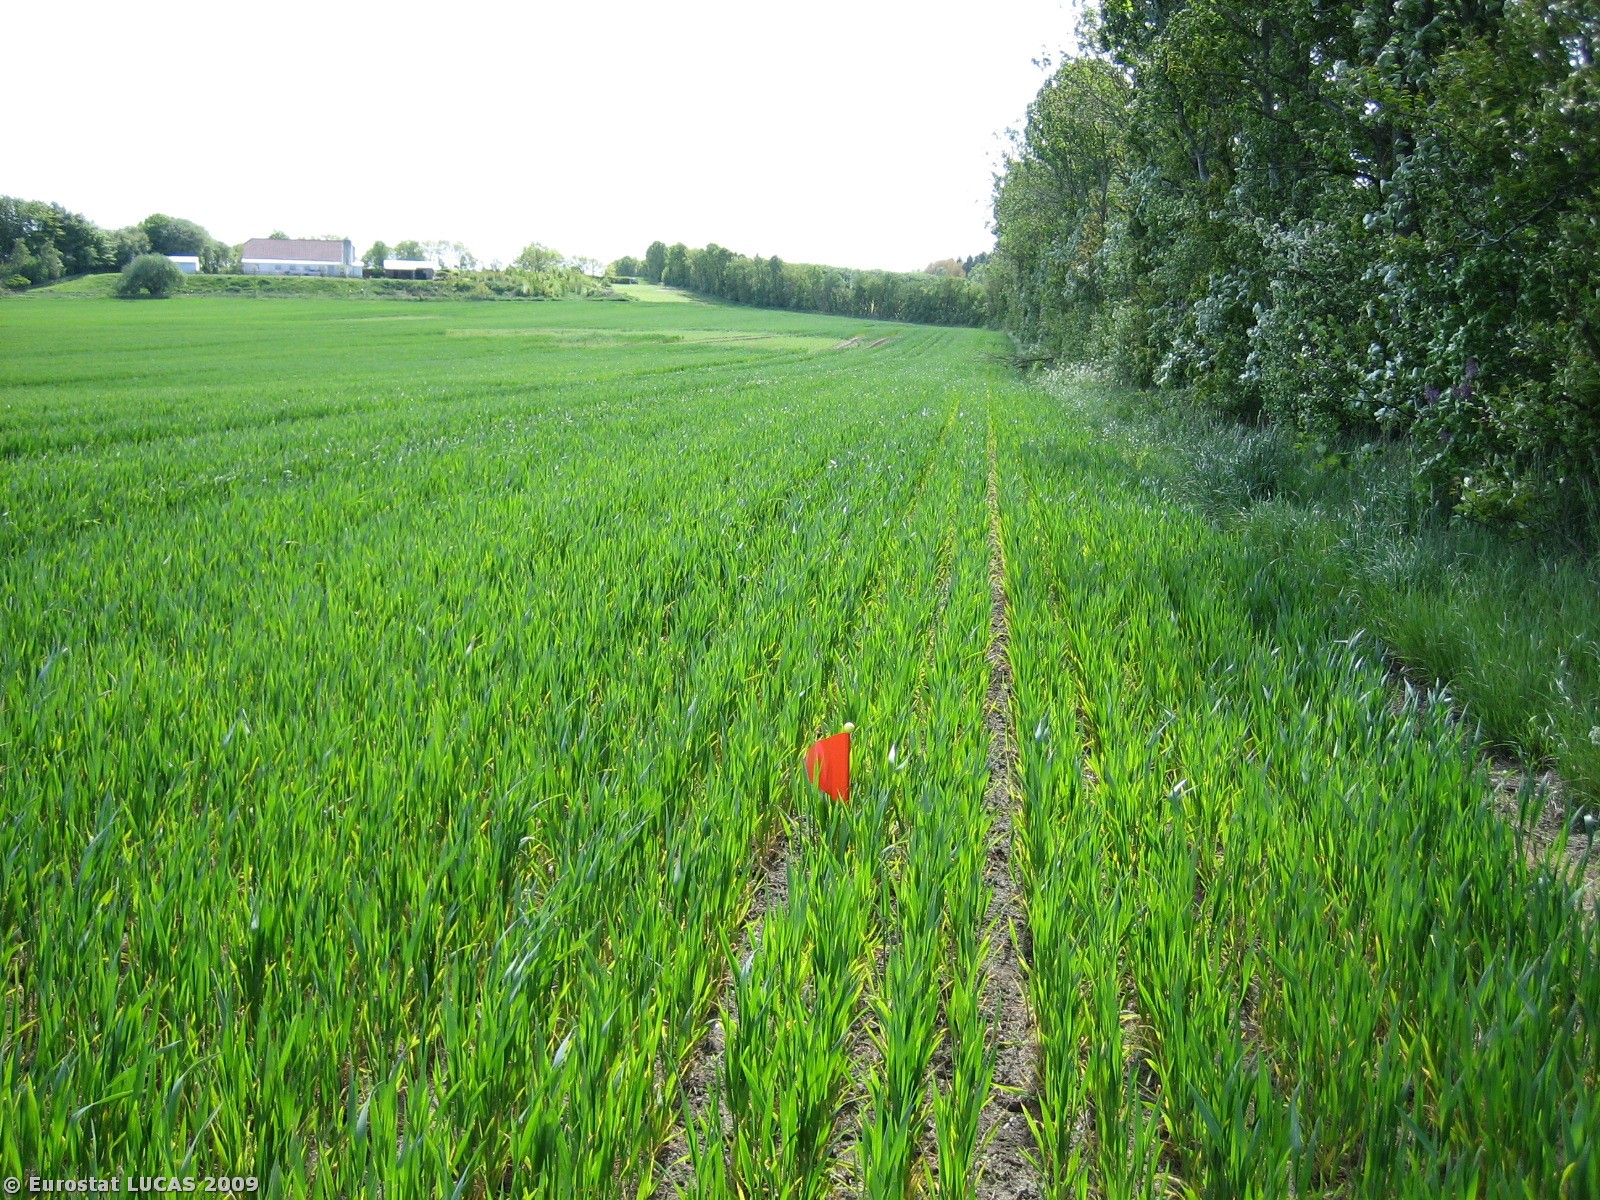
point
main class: Cropland
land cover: Barley
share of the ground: > 75 %
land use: Agriculture (excluding fallow land and kitchen gardens)
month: May
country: DK
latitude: 55.9990
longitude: 8.4783
